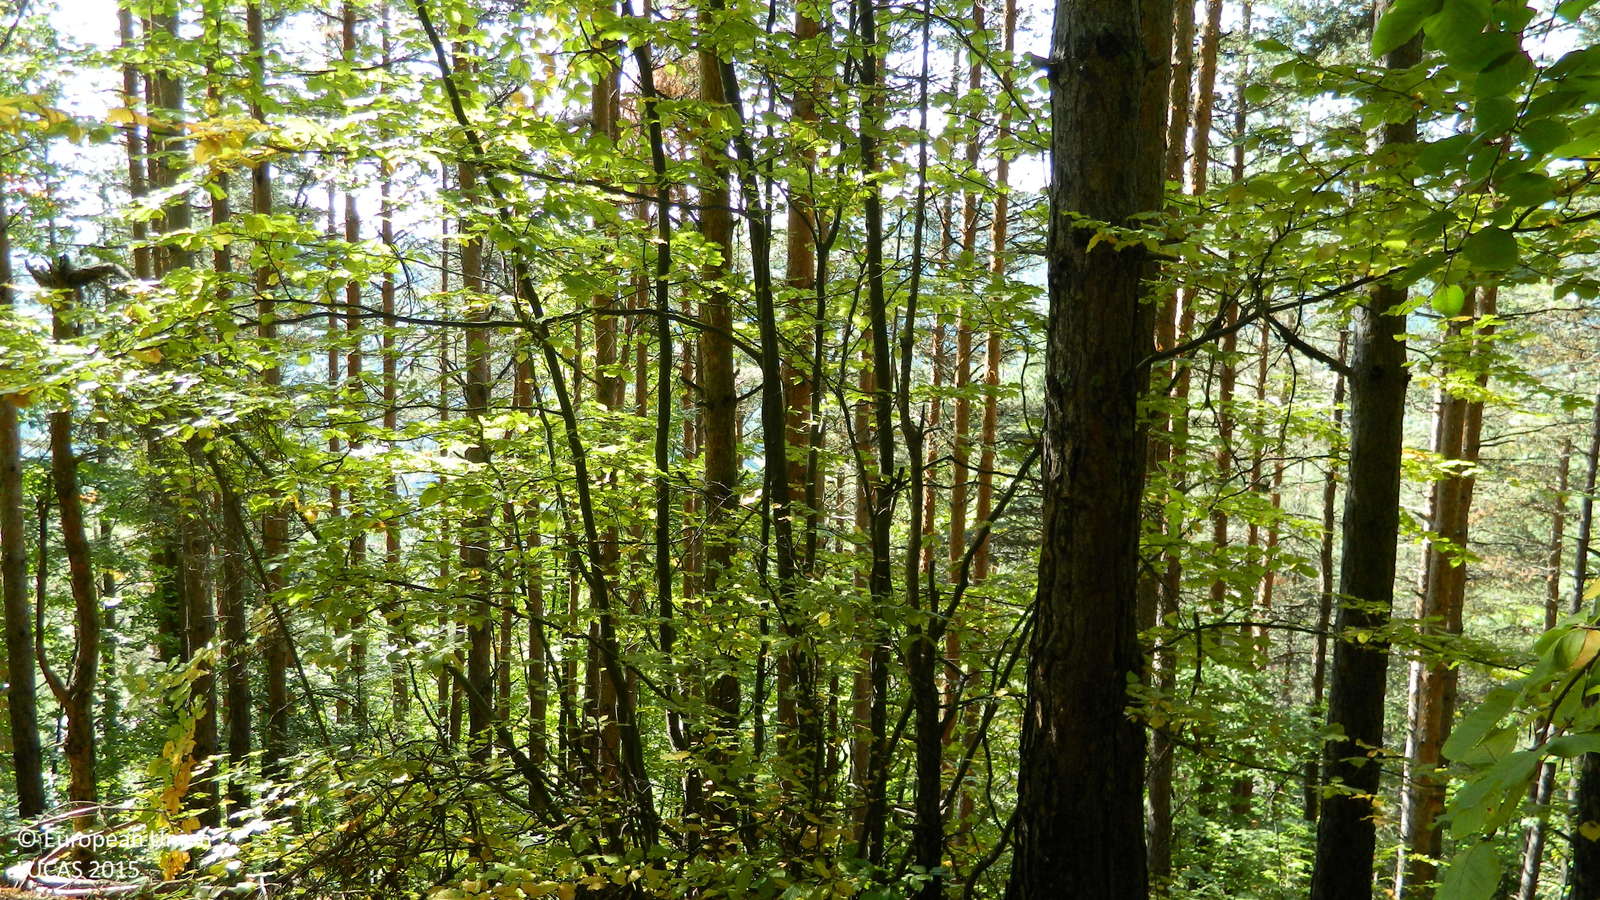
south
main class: Woodland
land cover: Pine dominated mixed woodland
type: mountainous beech forest
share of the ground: > 75 %
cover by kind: coniferous forest trees 50 %, broadleaved forest trees 50 %
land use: Forestry
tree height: > 5 m
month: October
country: BG
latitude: 41.6686
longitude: 24.9302
